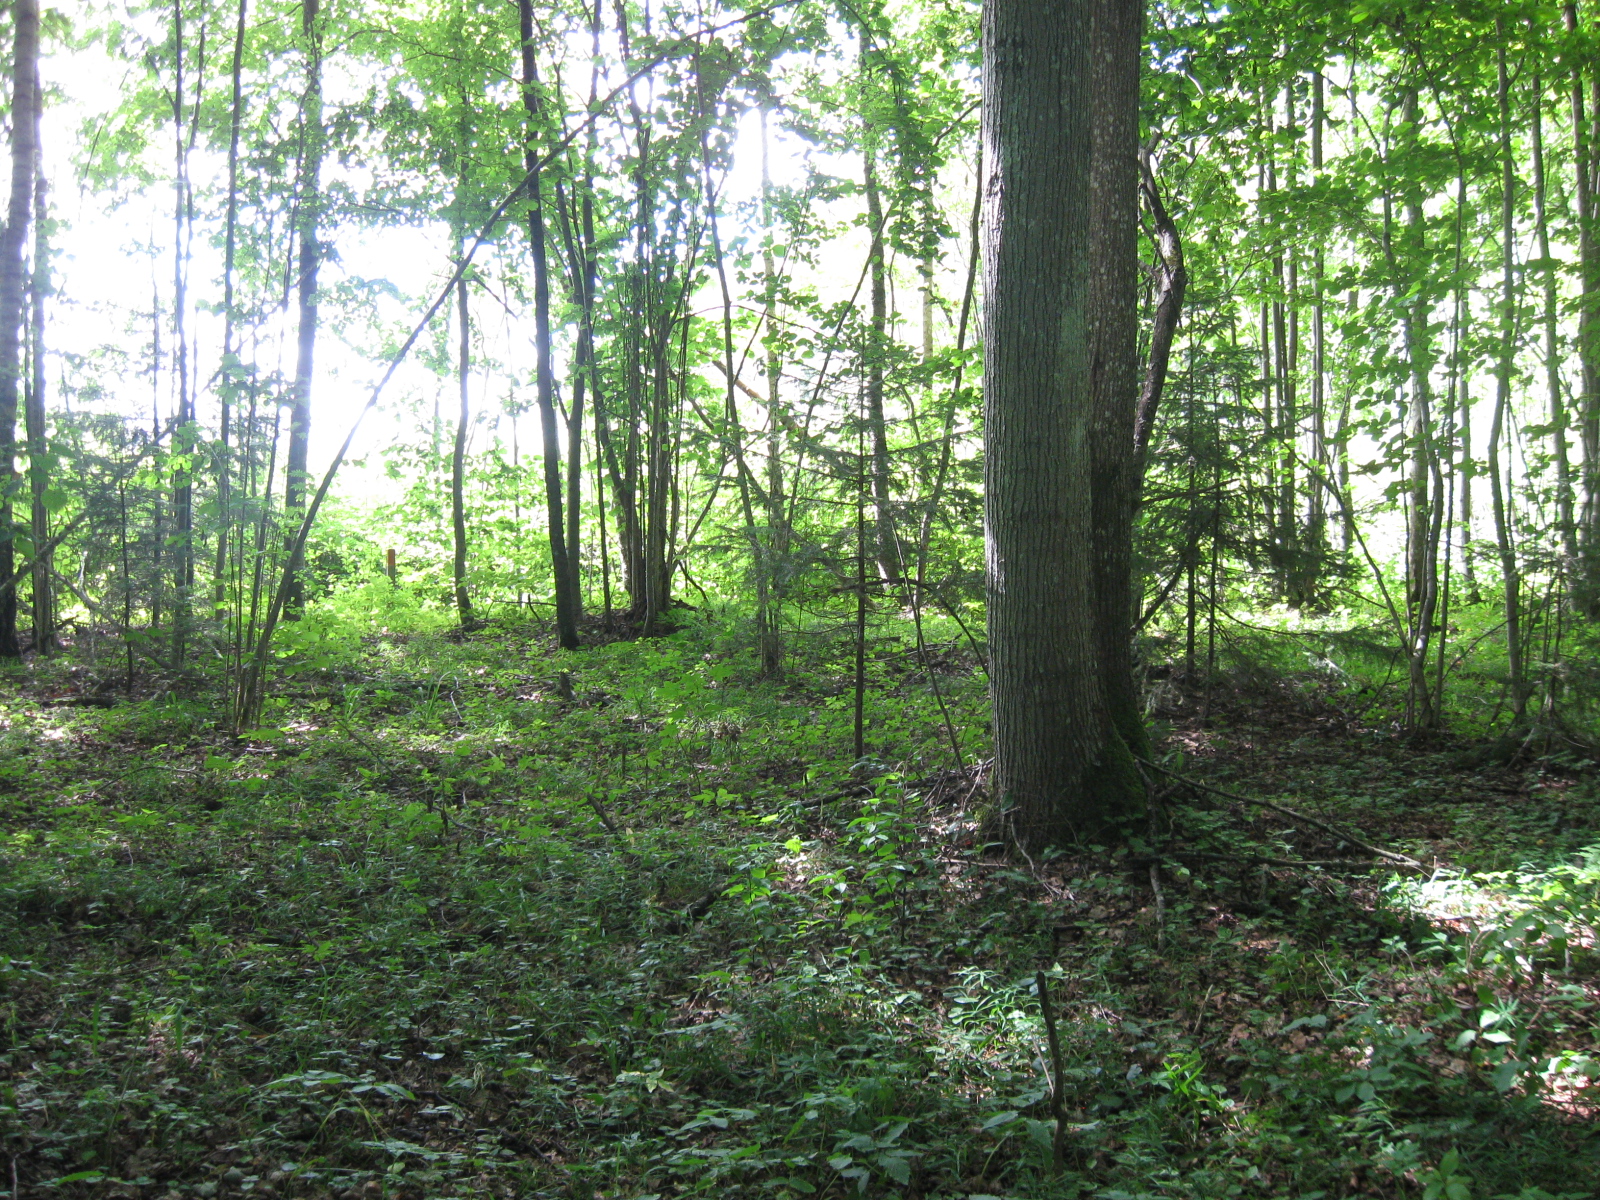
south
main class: Woodland
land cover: Other mixed woodland
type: hemiboreal forest and nemoral coniferous forest and mixed broadleaved-coniferous forest
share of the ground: > 75 %
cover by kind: broadleaved forest trees 65 %, coniferous forest trees 30 %, herbaceous plants 5 %
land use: Forestry
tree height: > 5 m
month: July
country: LT
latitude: 54.9742
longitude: 23.6921
